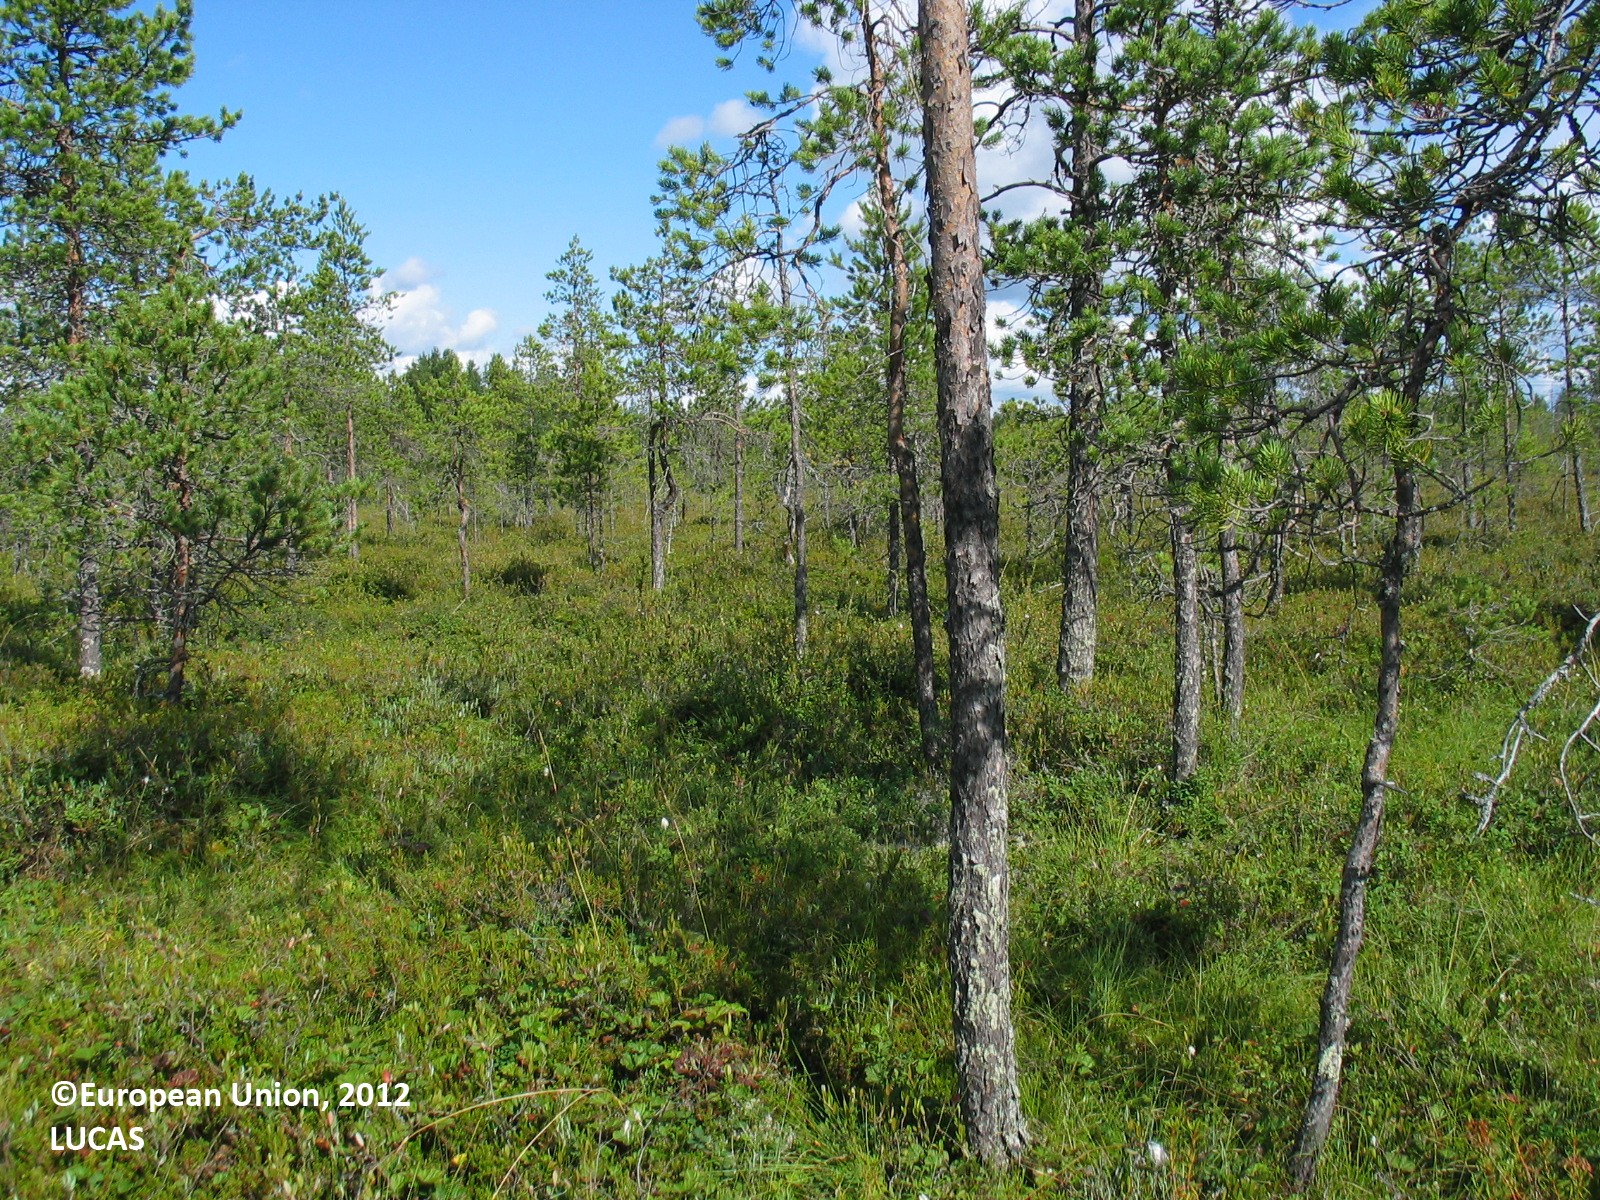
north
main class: Woodland
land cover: Pine dominated coniferous woodland
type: mire and swamp forests
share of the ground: 10 - 25 %
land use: Semi-natural and natural areas not in use
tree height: > 5 m
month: August
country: FI
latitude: 64.8026
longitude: 26.1643
